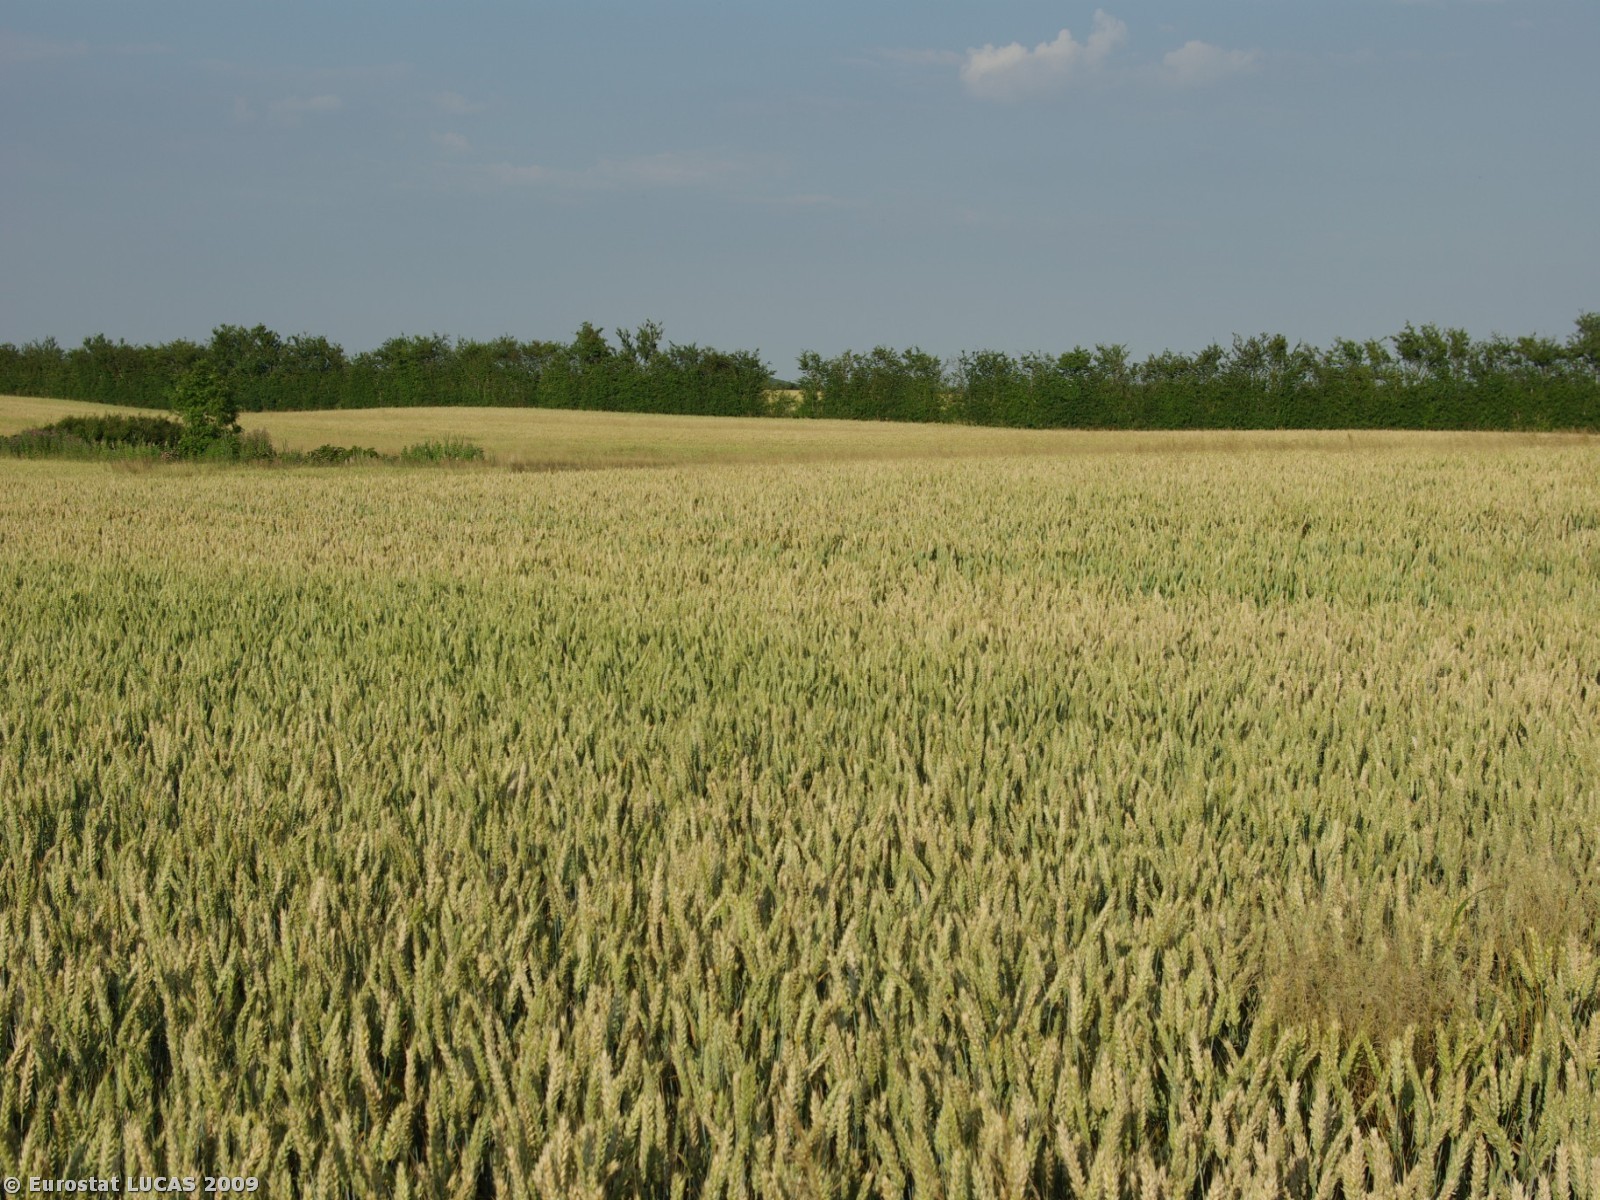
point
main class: Cropland
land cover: Common wheat
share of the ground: > 75 %
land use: Agriculture (excluding fallow land and kitchen gardens)
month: July
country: DK
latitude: 55.0191
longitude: 9.7343
